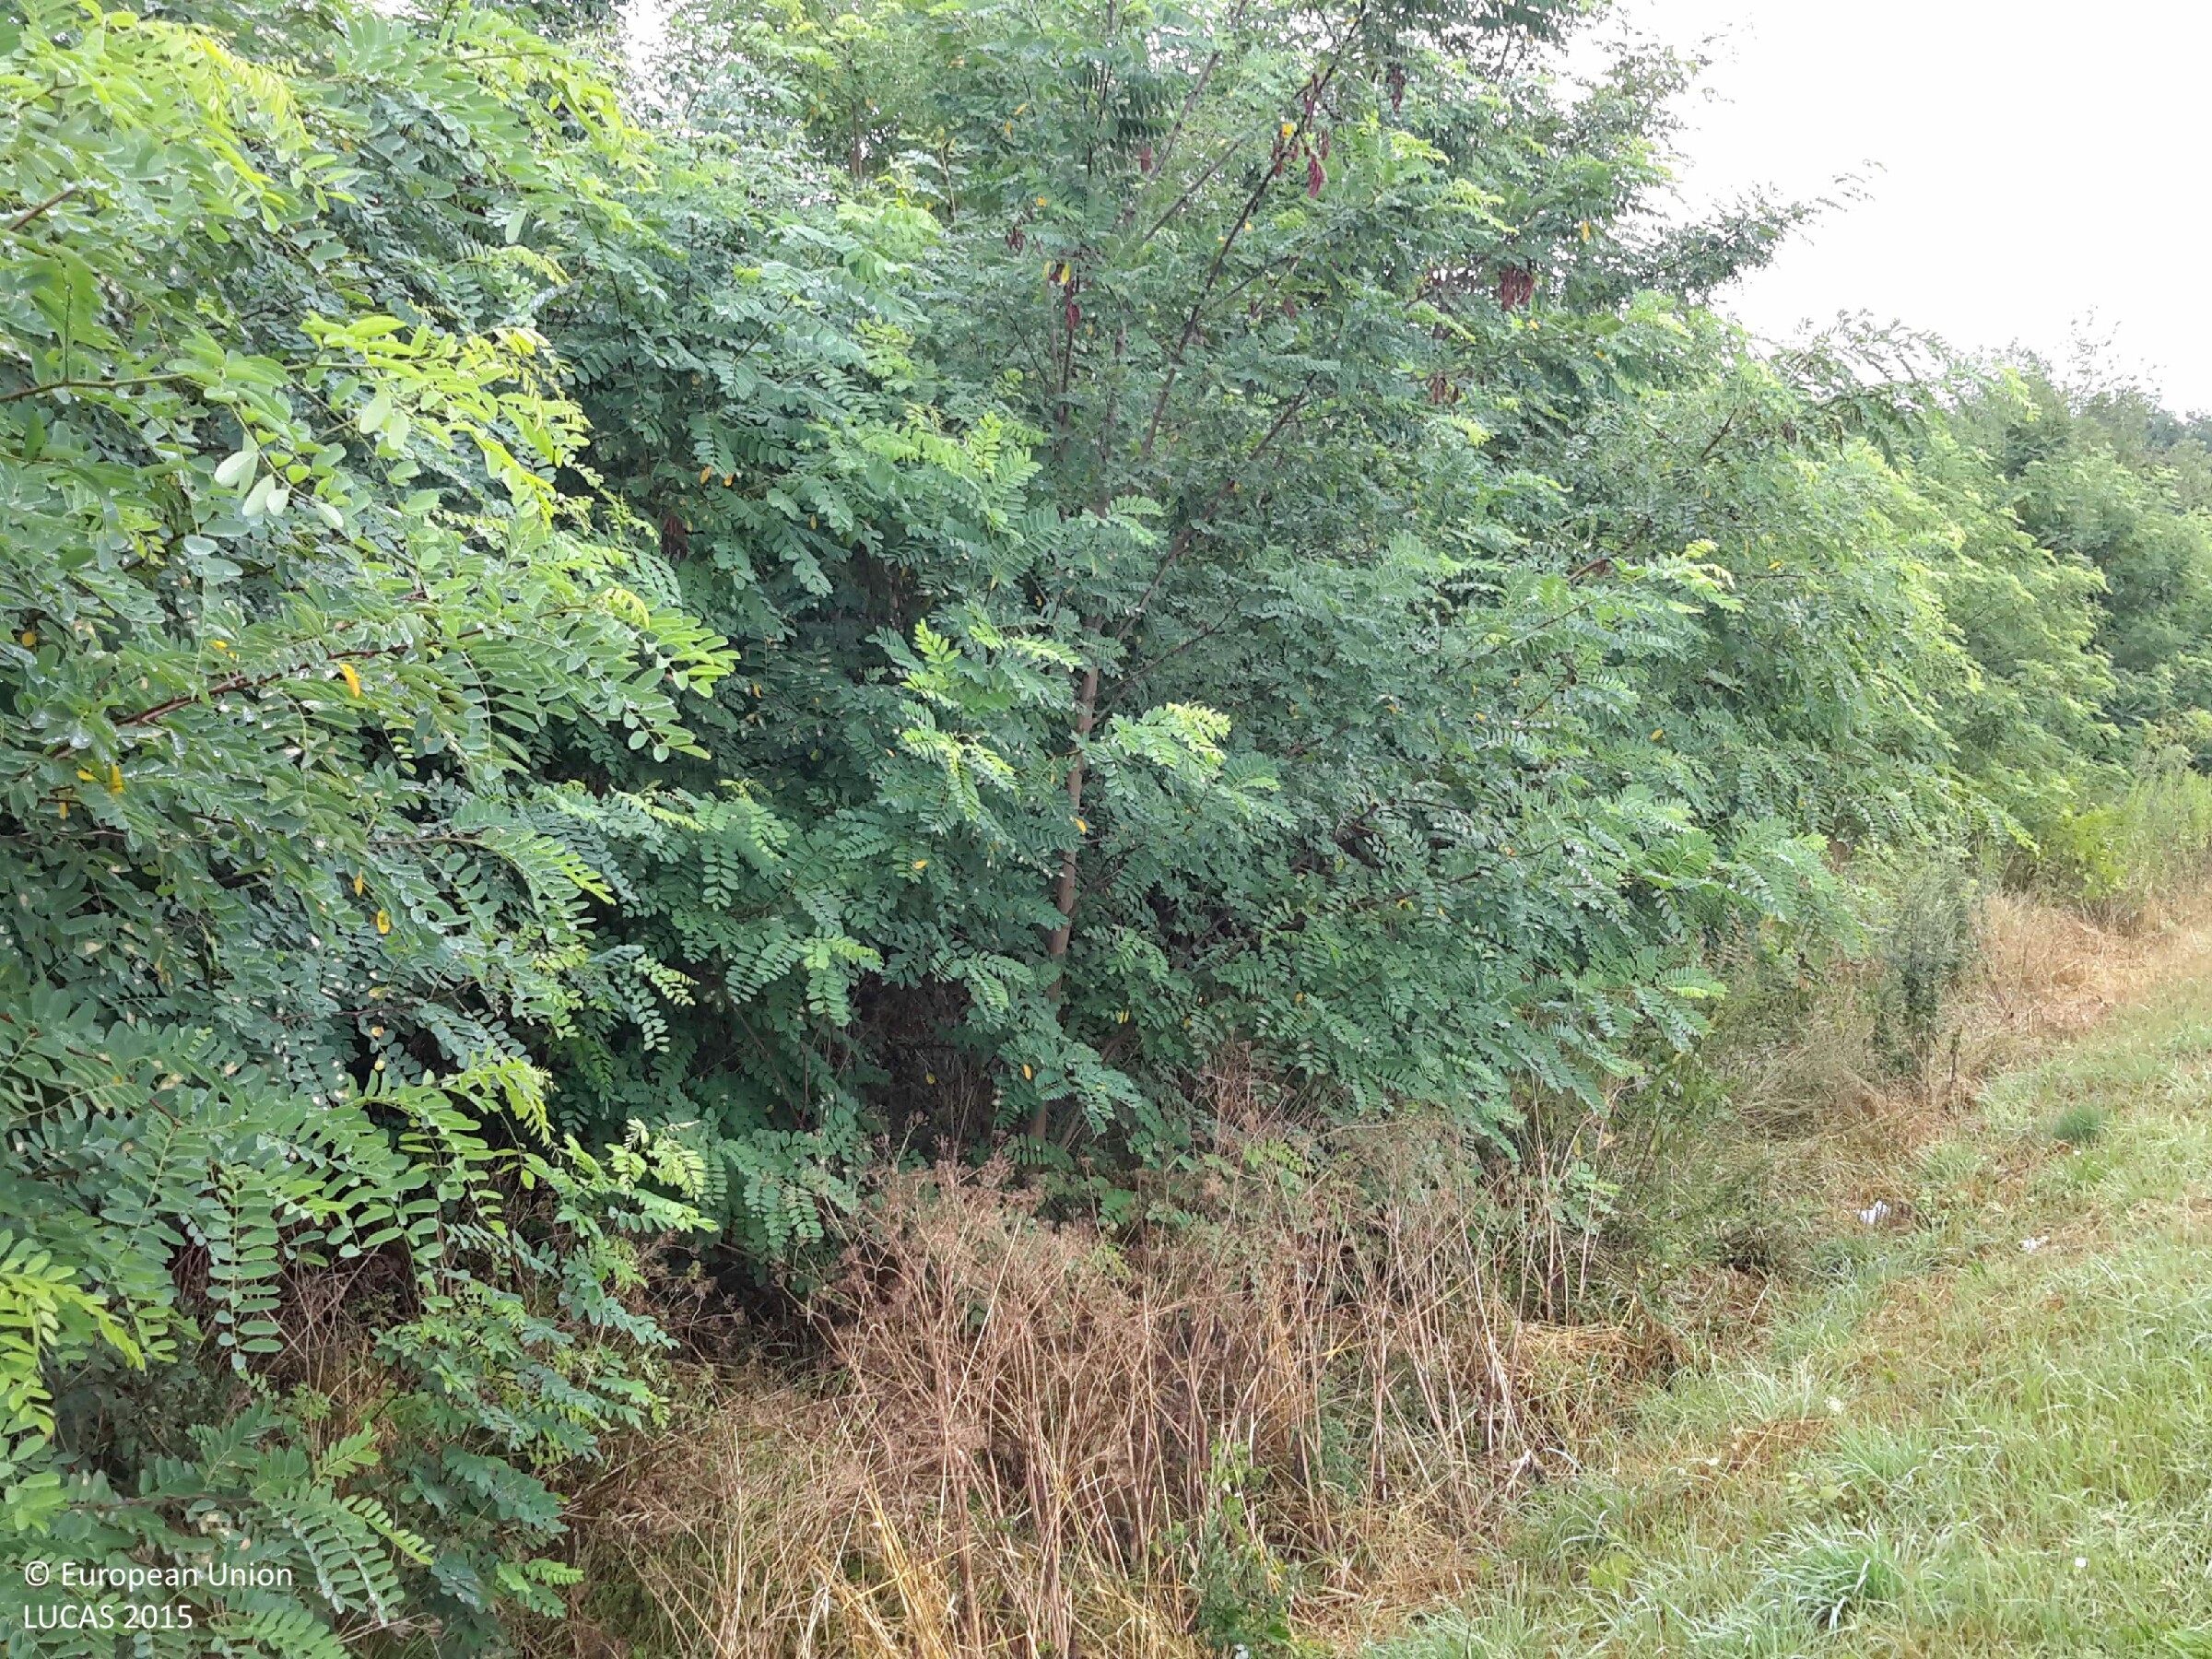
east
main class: Shrubland
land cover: Shrubland without tree cover
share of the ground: > 75 %
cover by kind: shrubs 100 %
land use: Forestry
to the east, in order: Shrubland without tree cover; Broadleaved woodland; Shrubland without tree cover
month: July
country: HU
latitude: 47.4634
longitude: 17.4766
